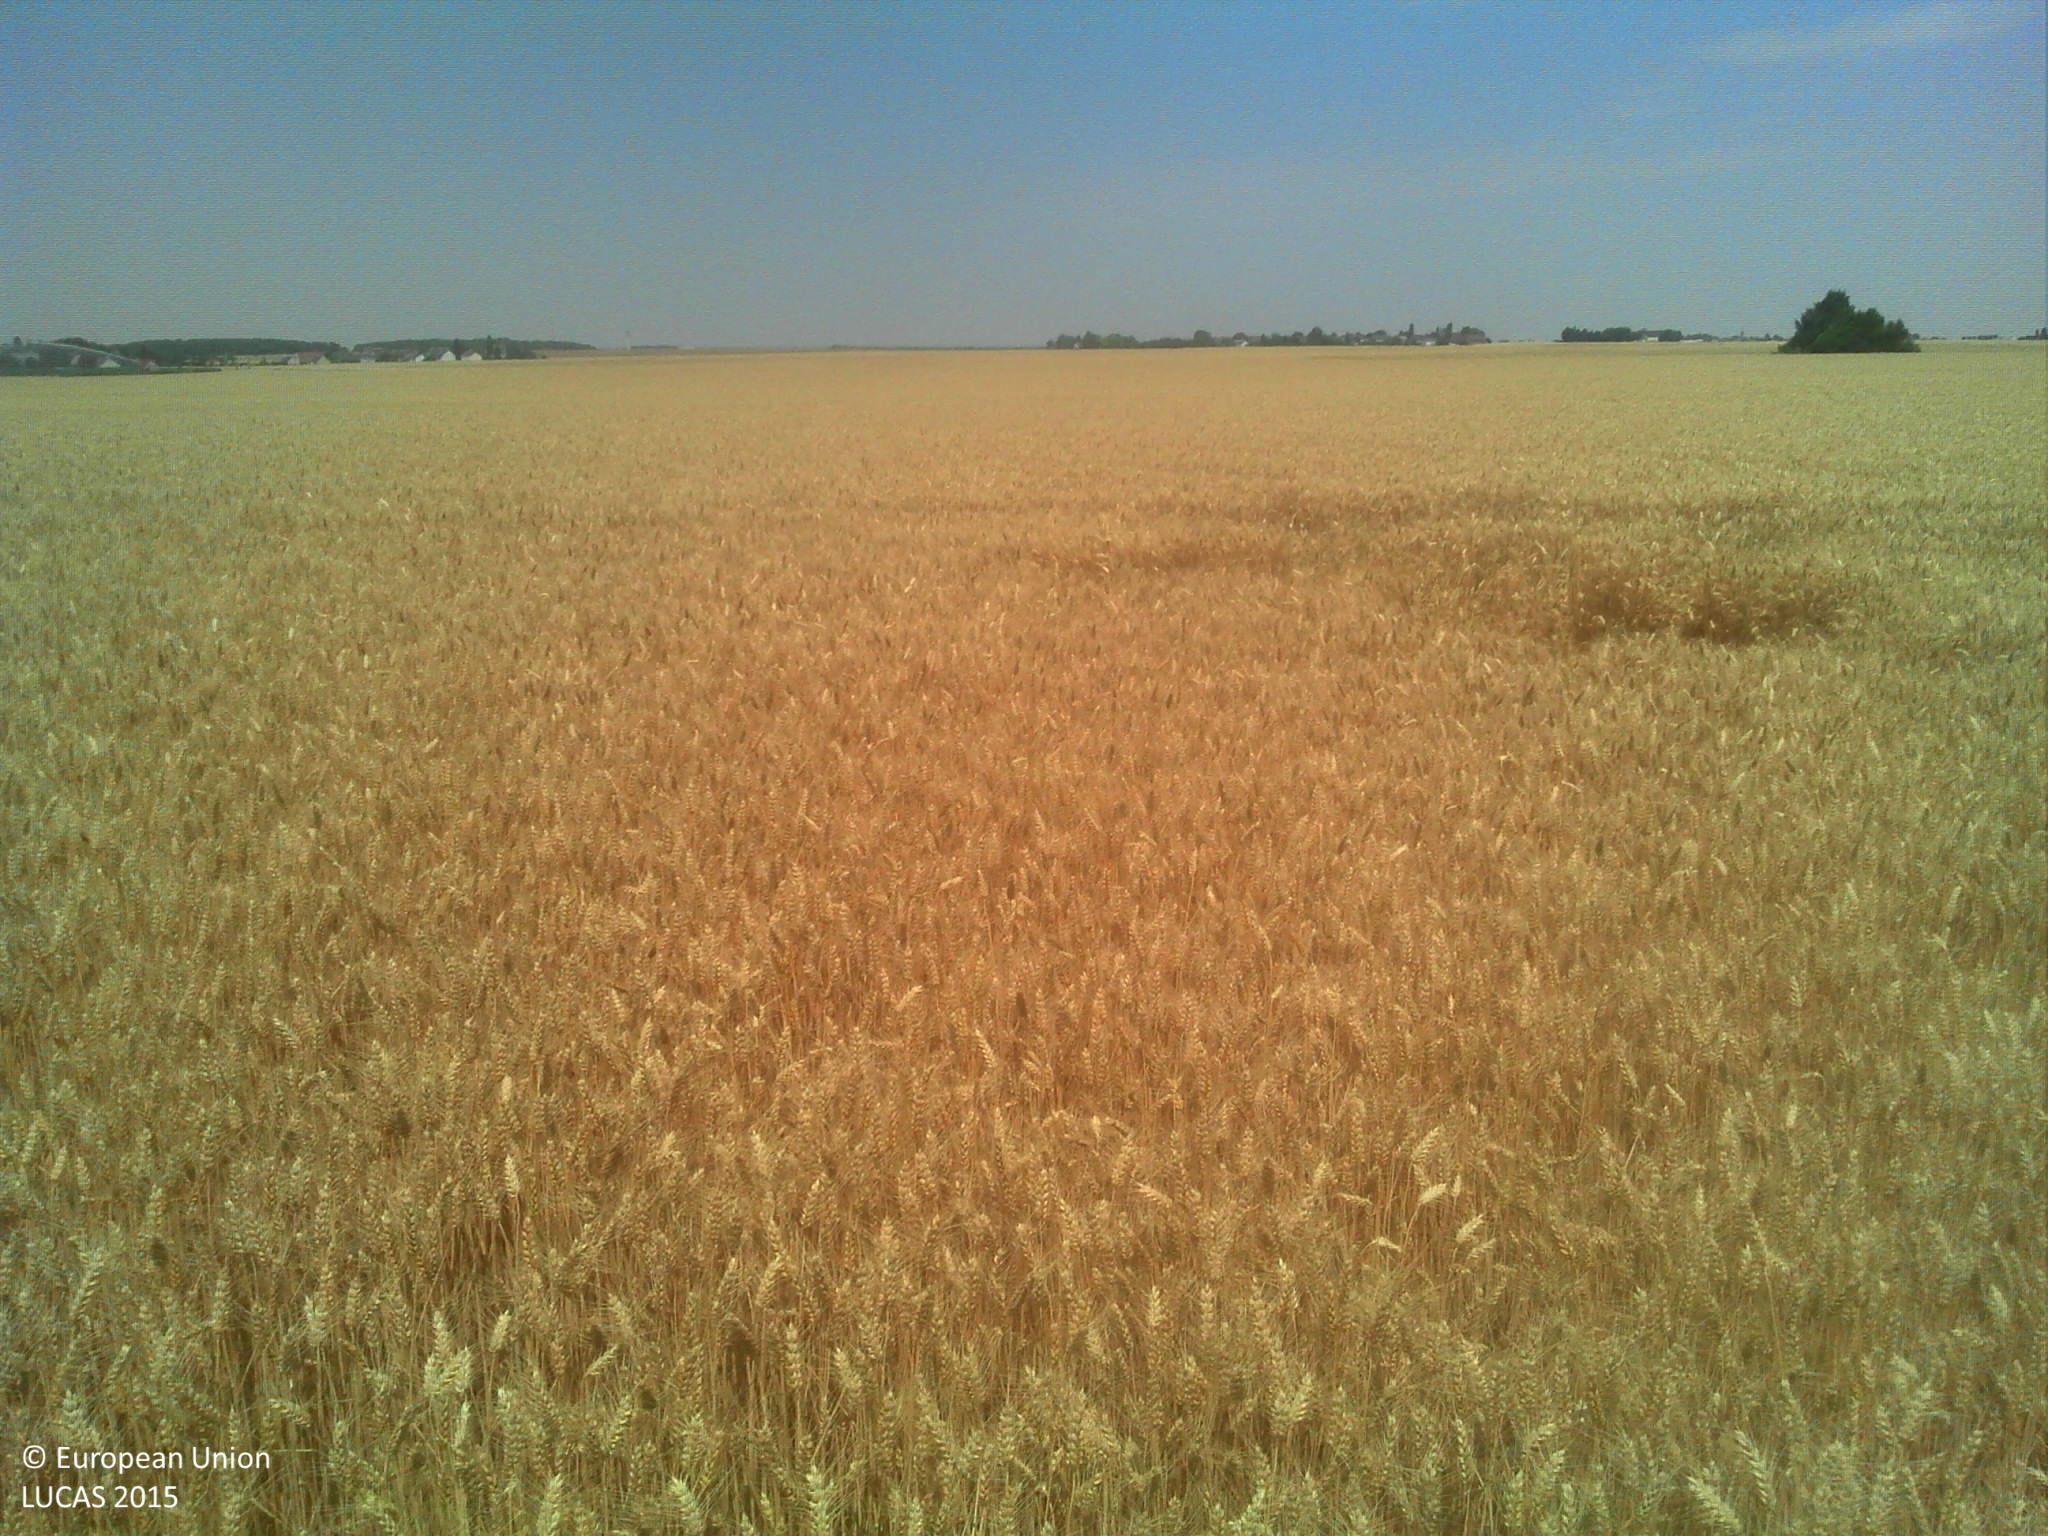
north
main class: Cropland
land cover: Durum wheat
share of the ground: > 75 %
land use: Agriculture (excluding fallow land and kitchen gardens)
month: July
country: FR
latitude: 47.6873
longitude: 1.3917
